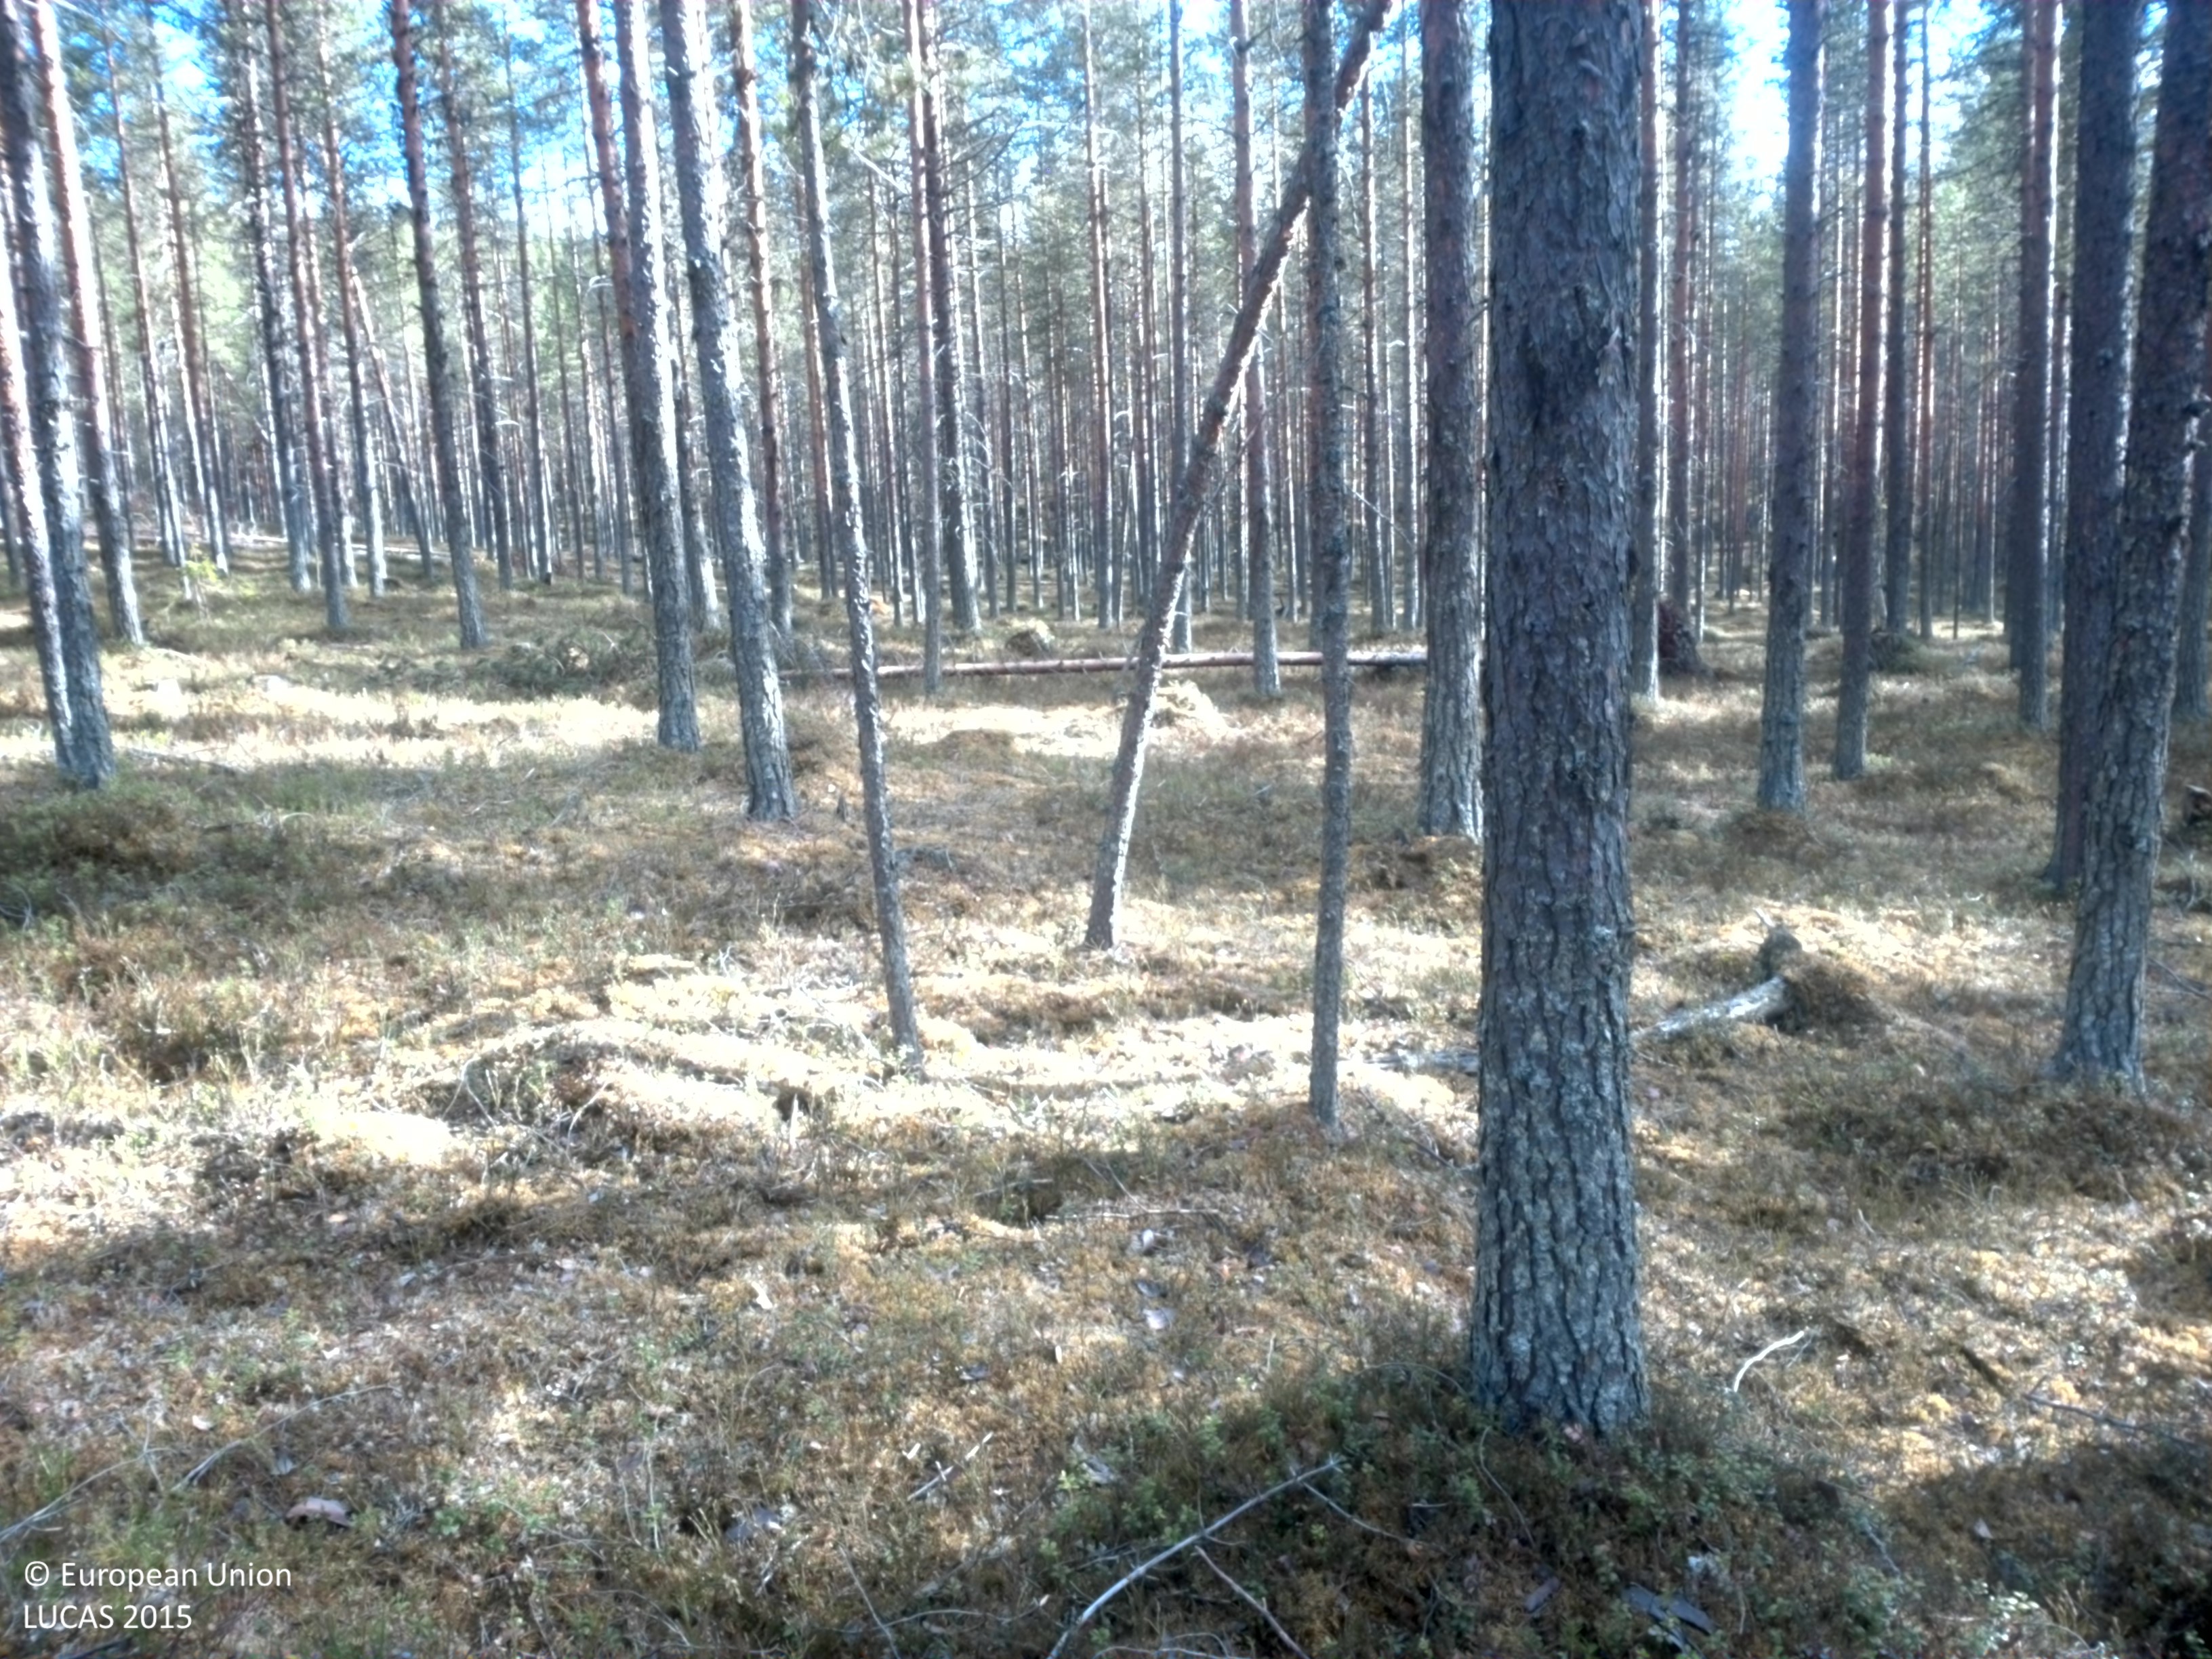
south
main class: Woodland
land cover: Pine dominated coniferous woodland
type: boreal forest
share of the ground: 25 - 50 %
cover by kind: lichens and mosses 45 %, coniferous forest trees 35 %, herbaceous plants 20 %
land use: Forestry
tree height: > 5 m
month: June
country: SE
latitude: 64.2785
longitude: 18.1681
